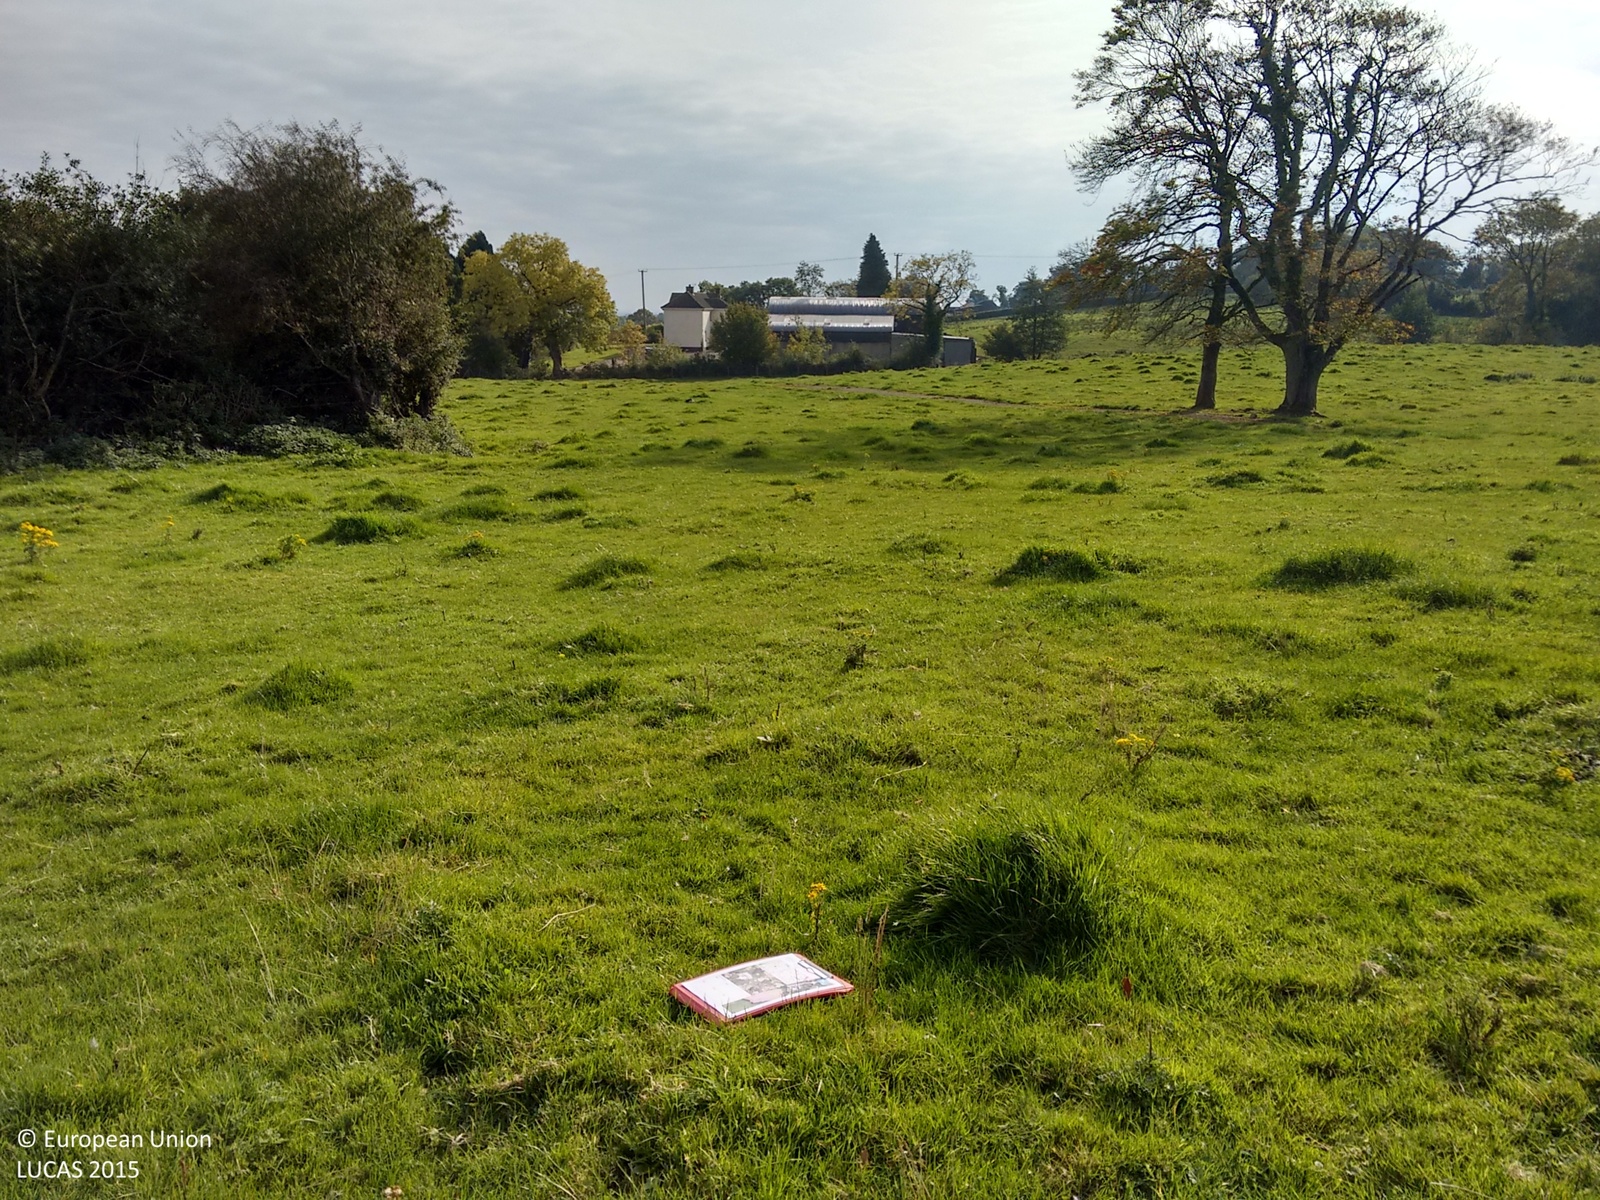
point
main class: Grassland
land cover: Grassland without tree/shrub cover
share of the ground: > 75 %
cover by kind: herbaceous plants 100 %
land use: Agriculture (excluding fallow land and kitchen gardens)
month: October
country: GB
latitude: 54.1837
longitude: -7.5819
